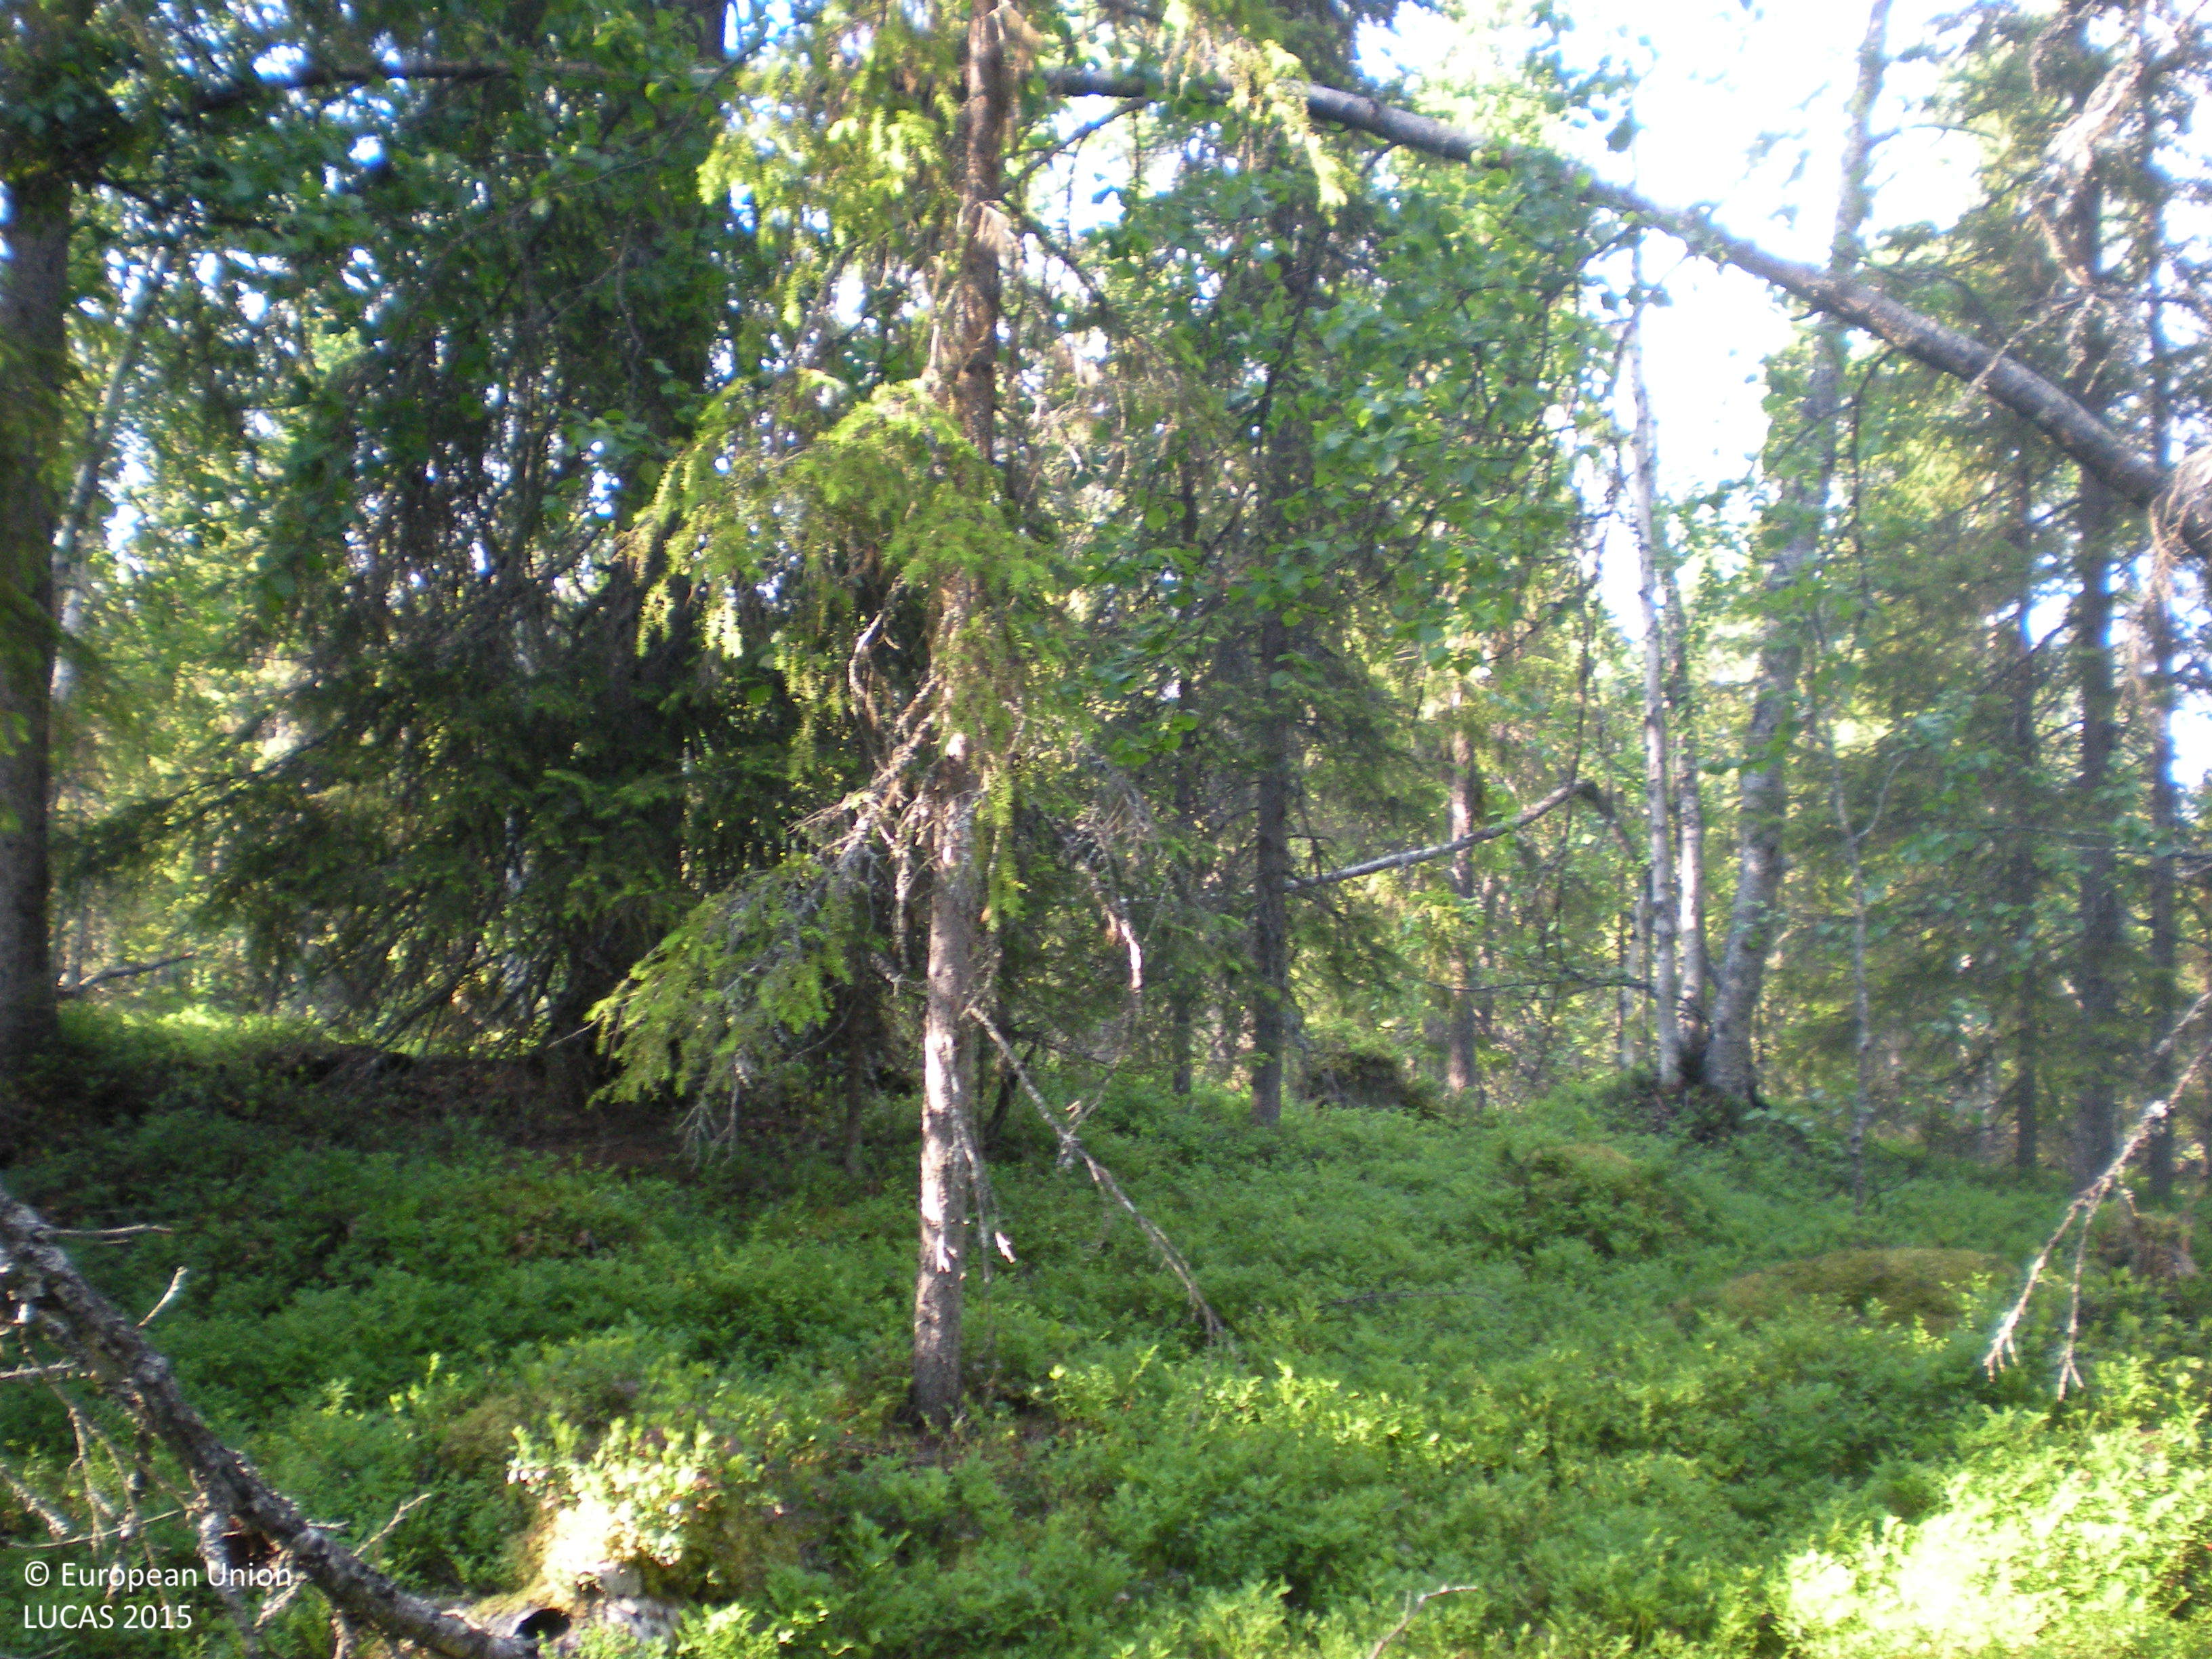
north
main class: Woodland
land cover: Spruce dominated mixed woodland
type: boreal forest
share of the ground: > 75 %
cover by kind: coniferous forest trees 50 %, broadleaved forest trees 25 %, shrubs 20 %, lichens and mosses 5 %
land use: Forestry
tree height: > 5 m
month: July
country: SE
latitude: 65.6061
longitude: 16.9686
